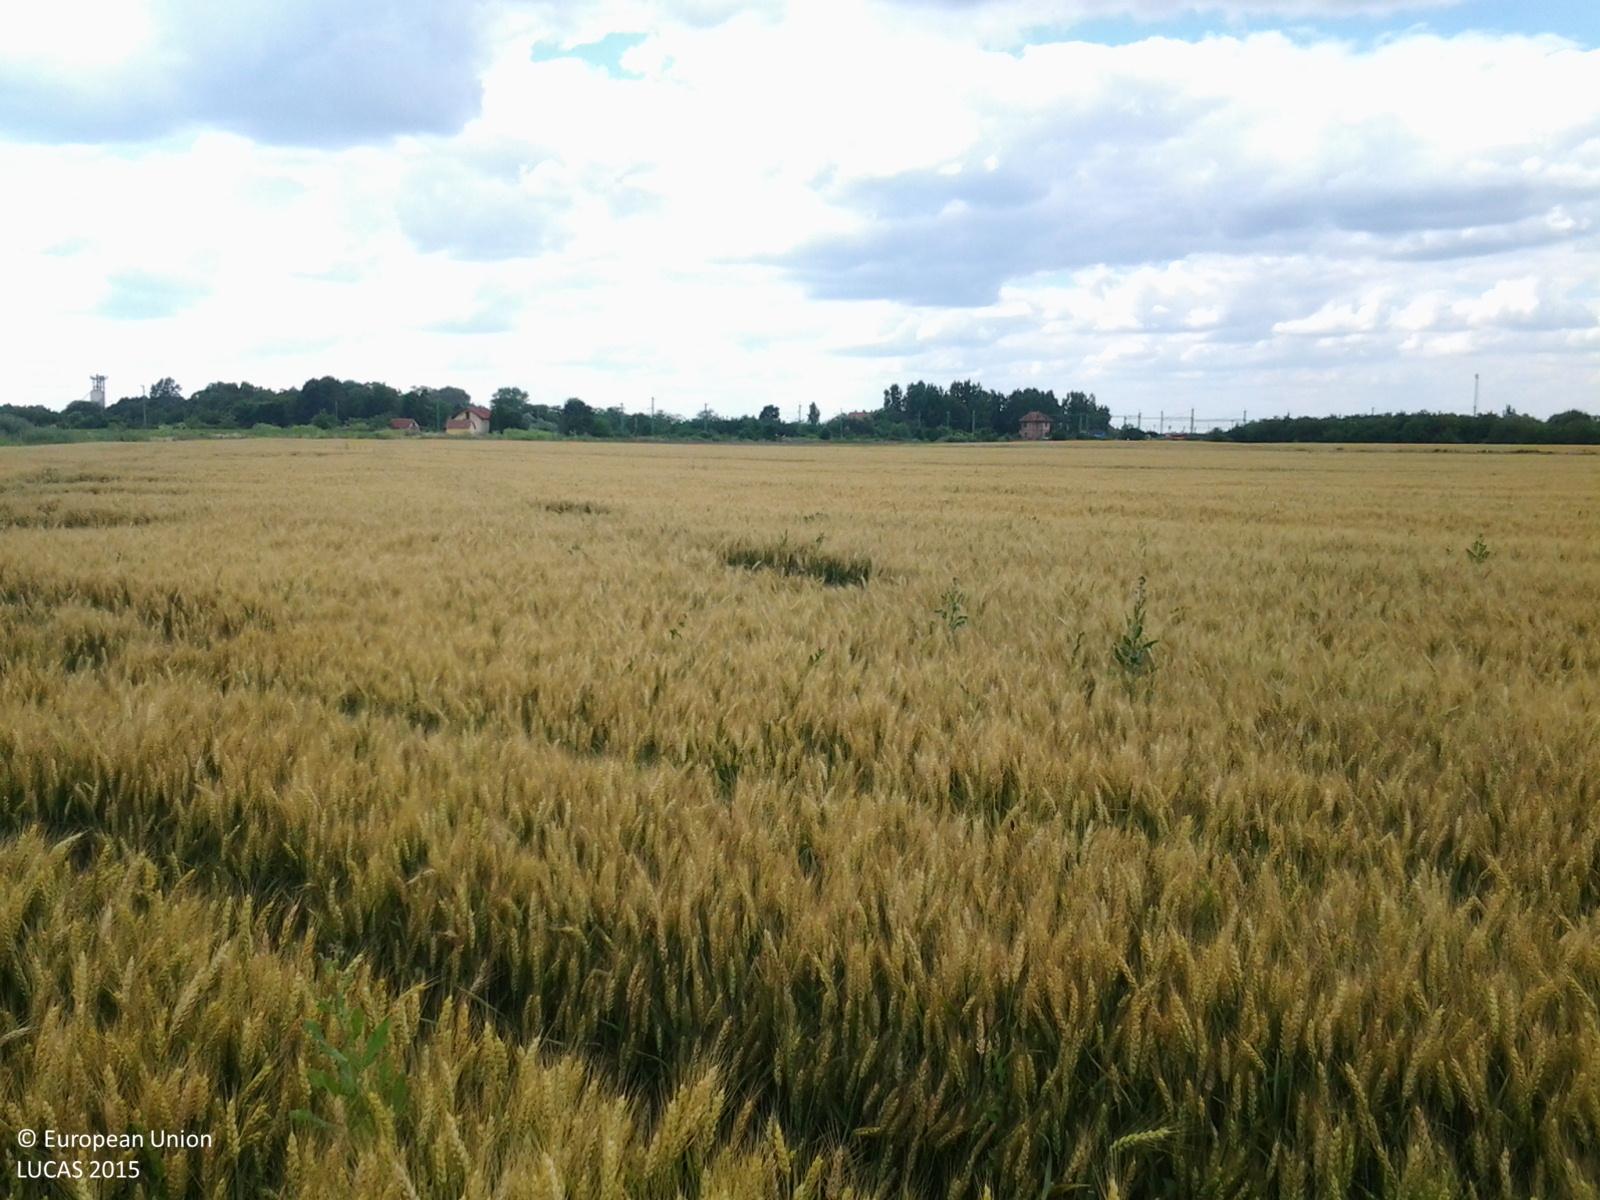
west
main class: Cropland
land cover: Common wheat
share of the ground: > 75 %
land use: Agriculture (excluding fallow land and kitchen gardens)
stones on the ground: < 10 %
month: June
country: HU
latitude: 46.5264
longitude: 21.1803
